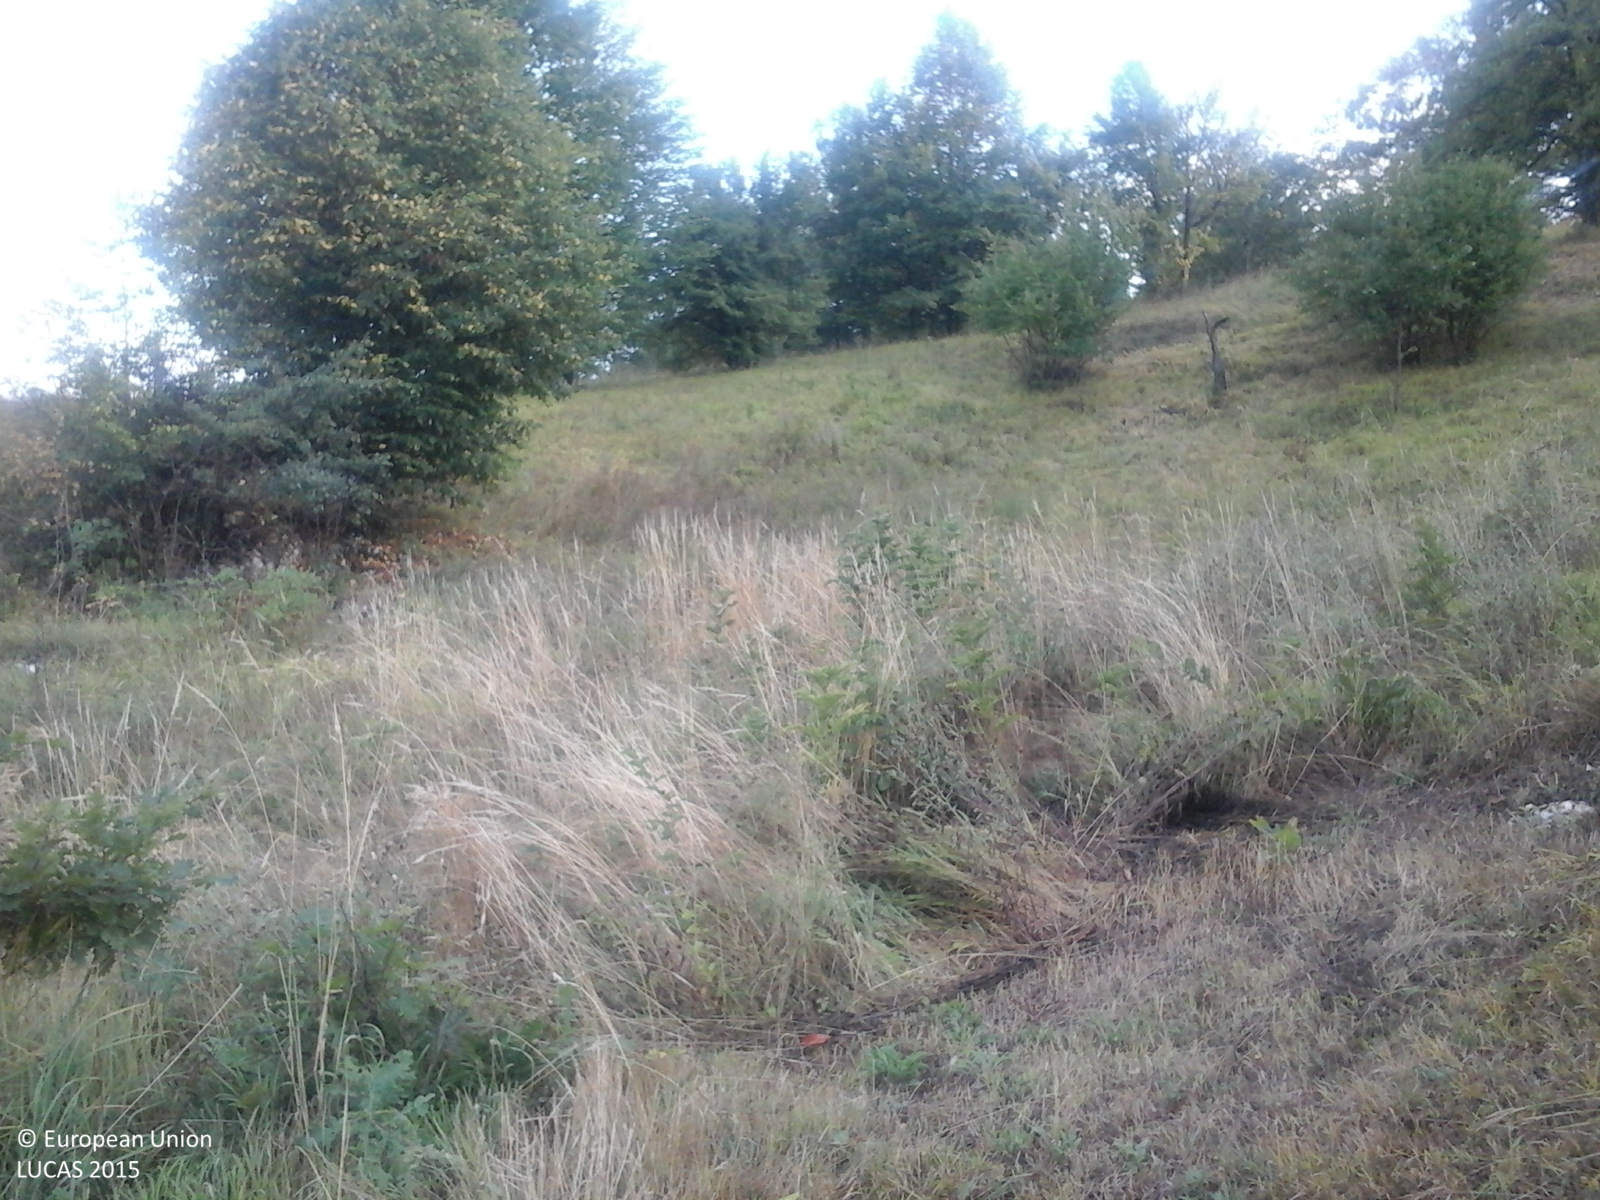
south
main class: Grassland
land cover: Grassland without tree/shrub cover
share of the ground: > 75 %
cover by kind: herbaceous plants 100 %
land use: Agriculture (excluding fallow land and kitchen gardens)
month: August
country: RO
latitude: 44.8419
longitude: 21.7844
